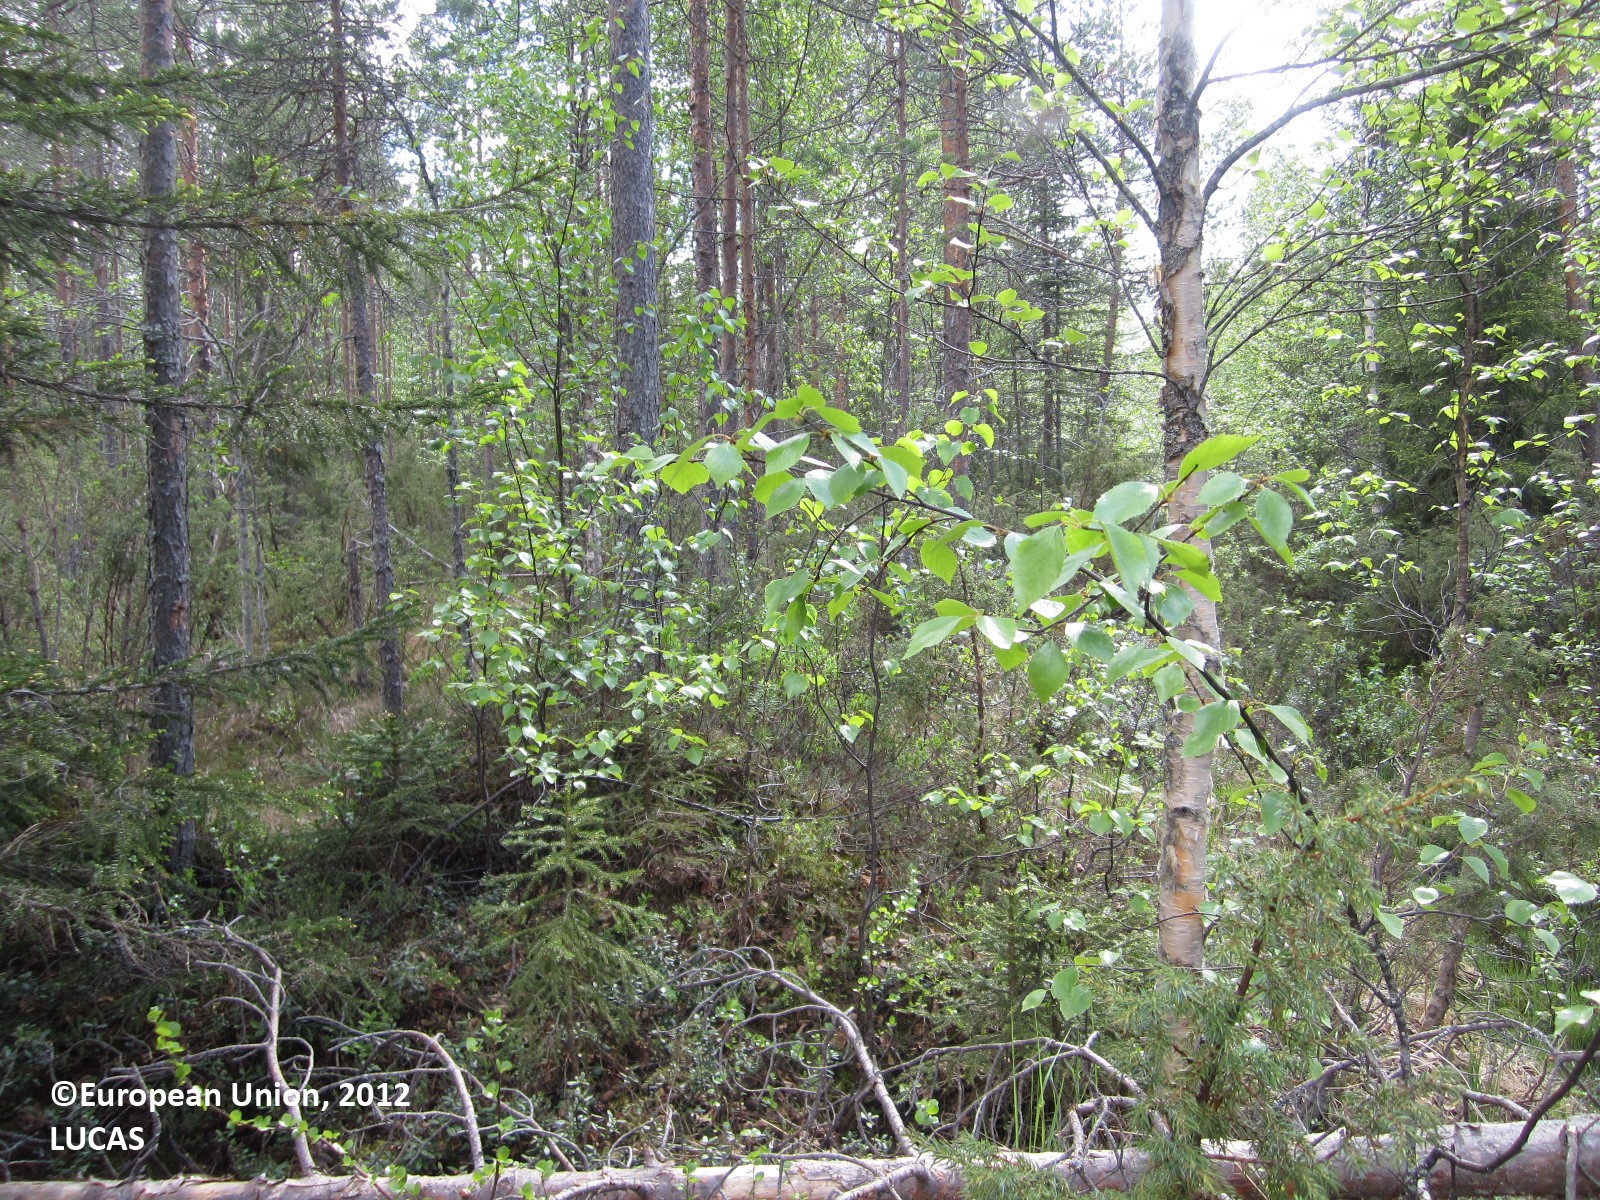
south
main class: Woodland
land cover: Other coniferous woodland
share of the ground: 50 - 75 %
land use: Forestry
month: June
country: FI
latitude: 64.5903
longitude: 28.7527
